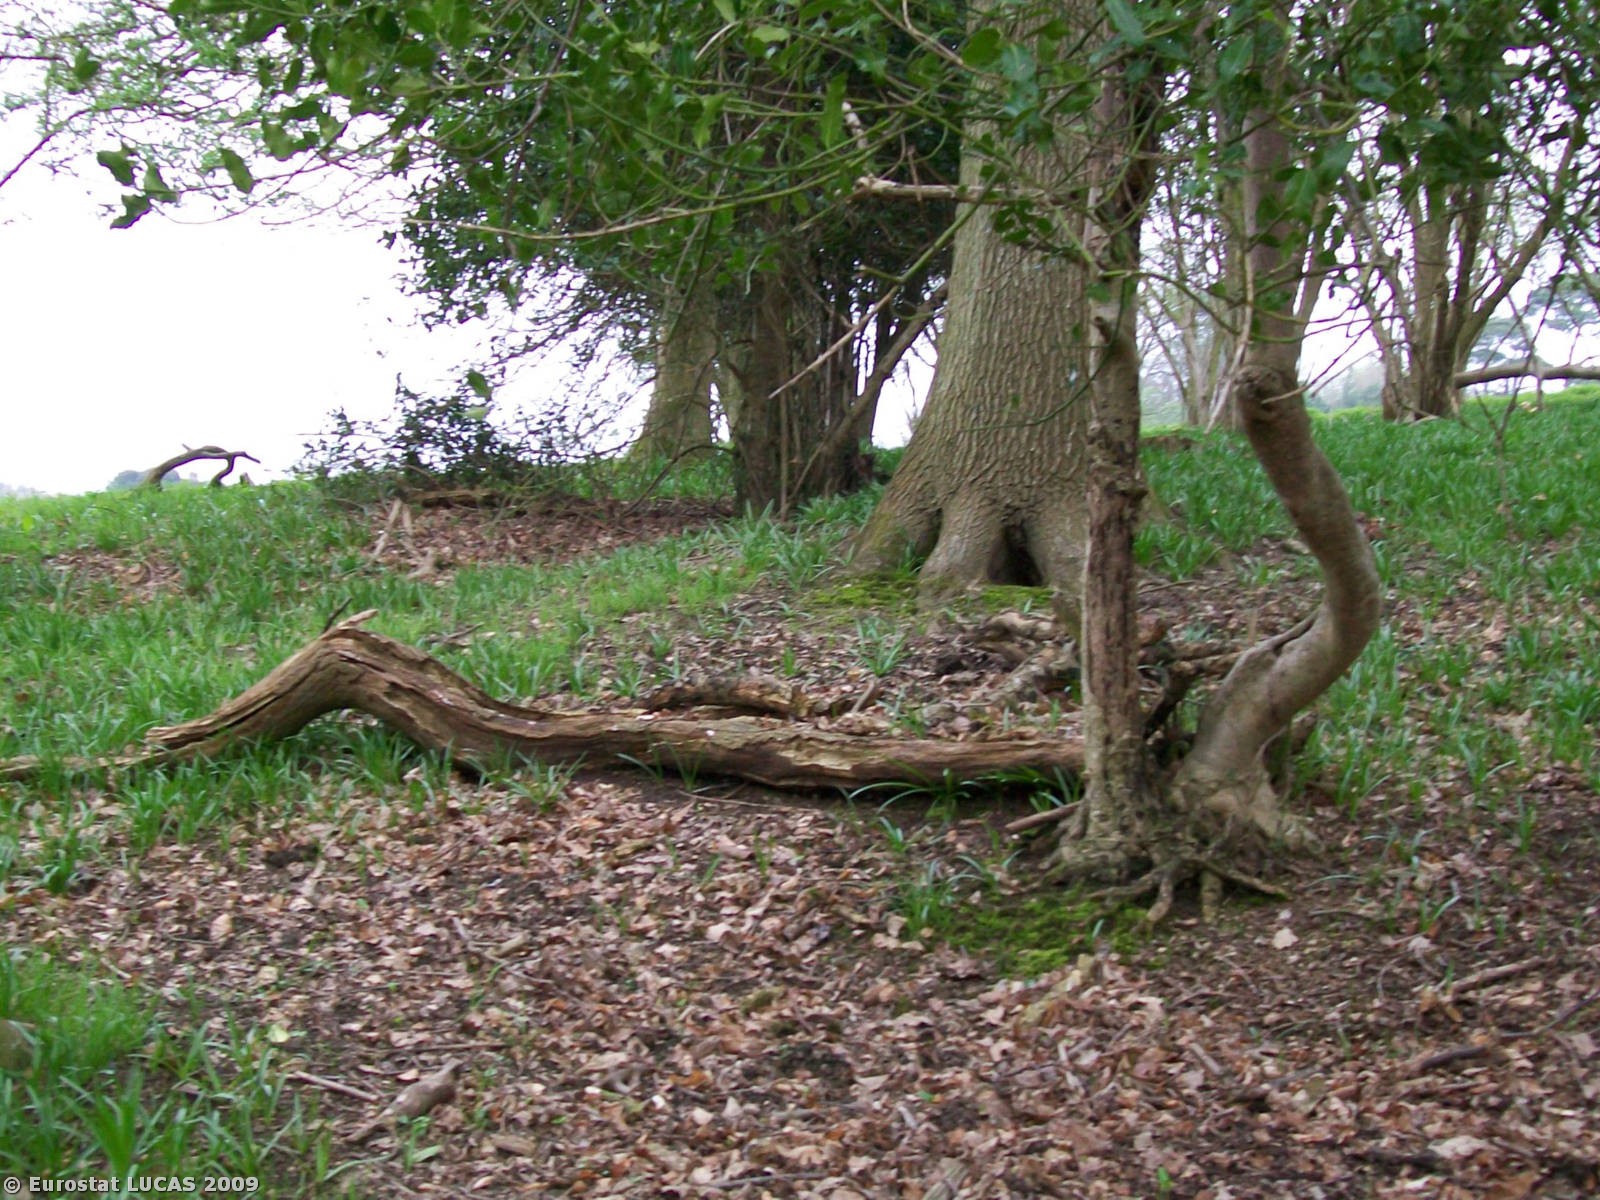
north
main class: Woodland
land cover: Mixed woodland
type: mesophytic deciduous forest
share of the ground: > 75 %
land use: Forestry
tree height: > 5 m
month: April
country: GB
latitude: 50.9523
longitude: 0.3622
